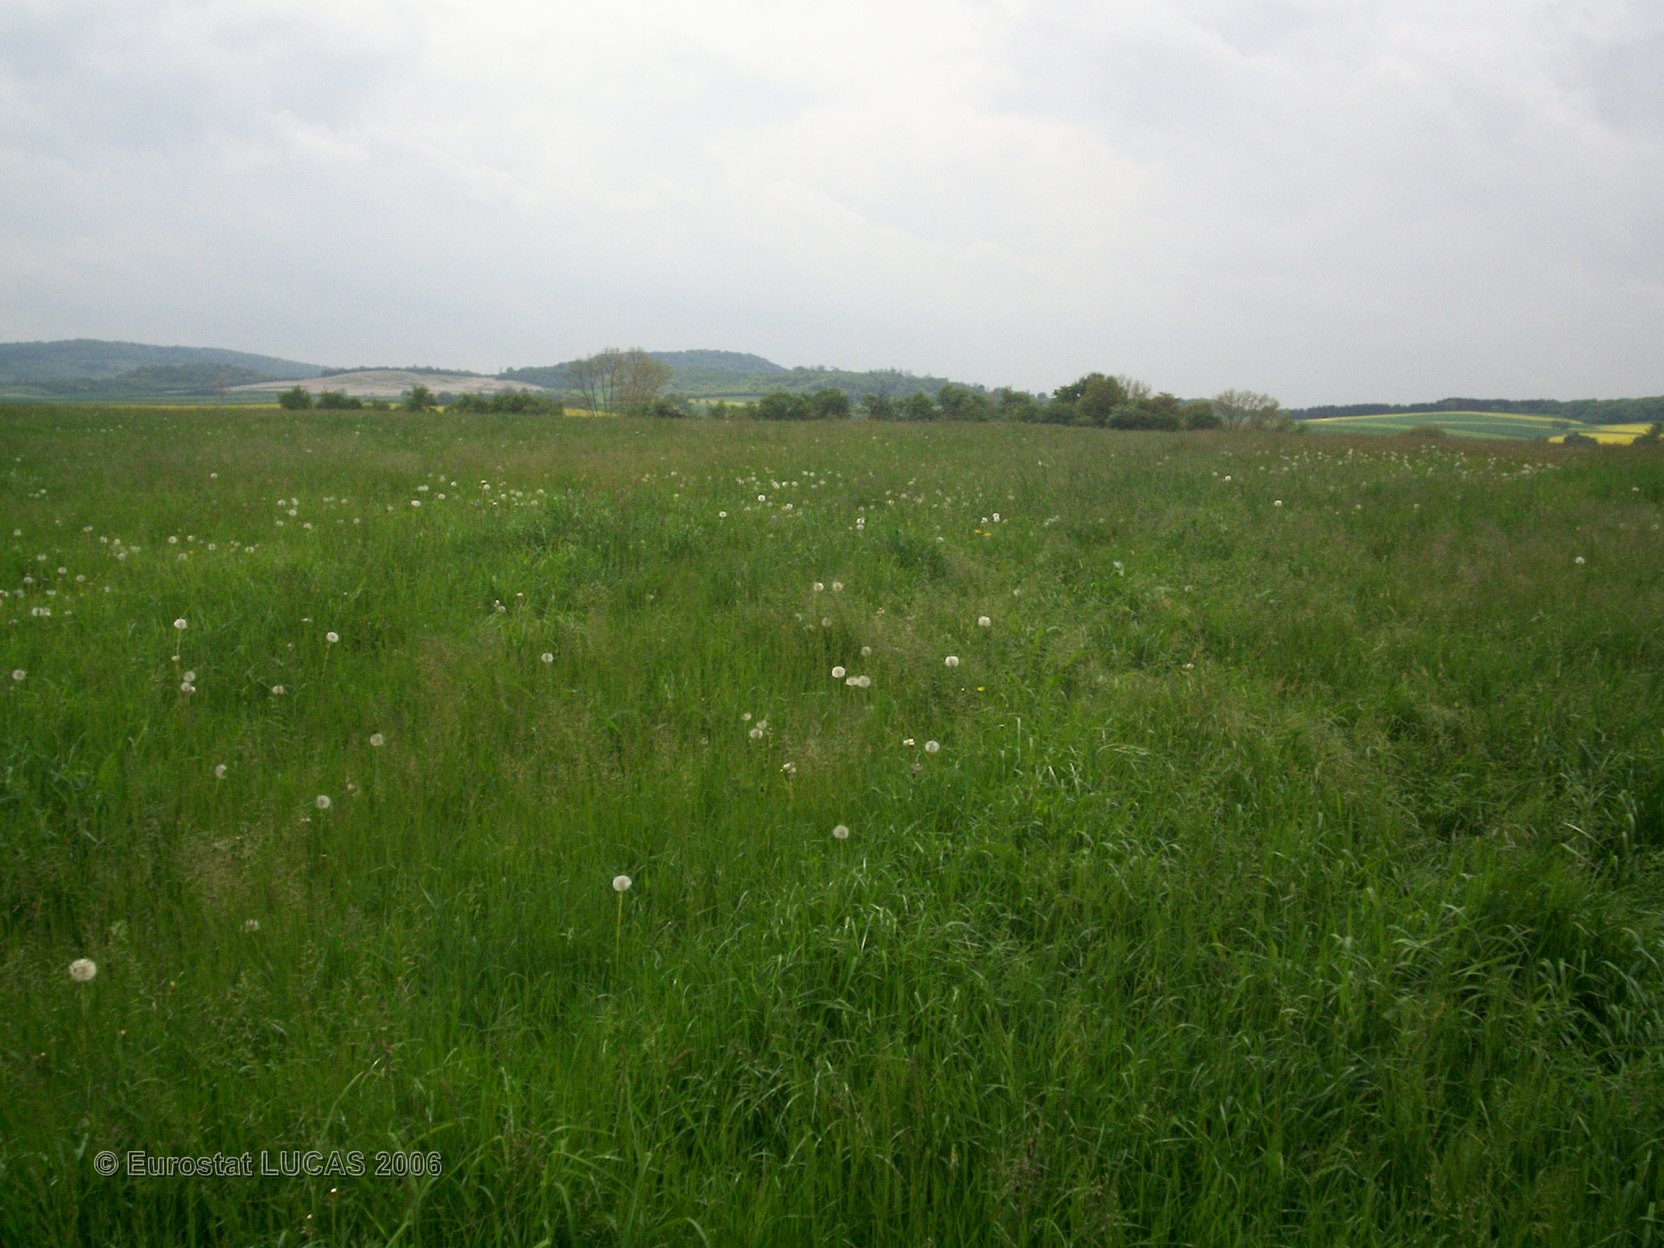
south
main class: Grassland
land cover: Grassland without tree/shrub cover
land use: Agriculture (excluding fallow land and kitchen gardens)
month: May
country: FR
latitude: 49.3536
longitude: 6.4067
